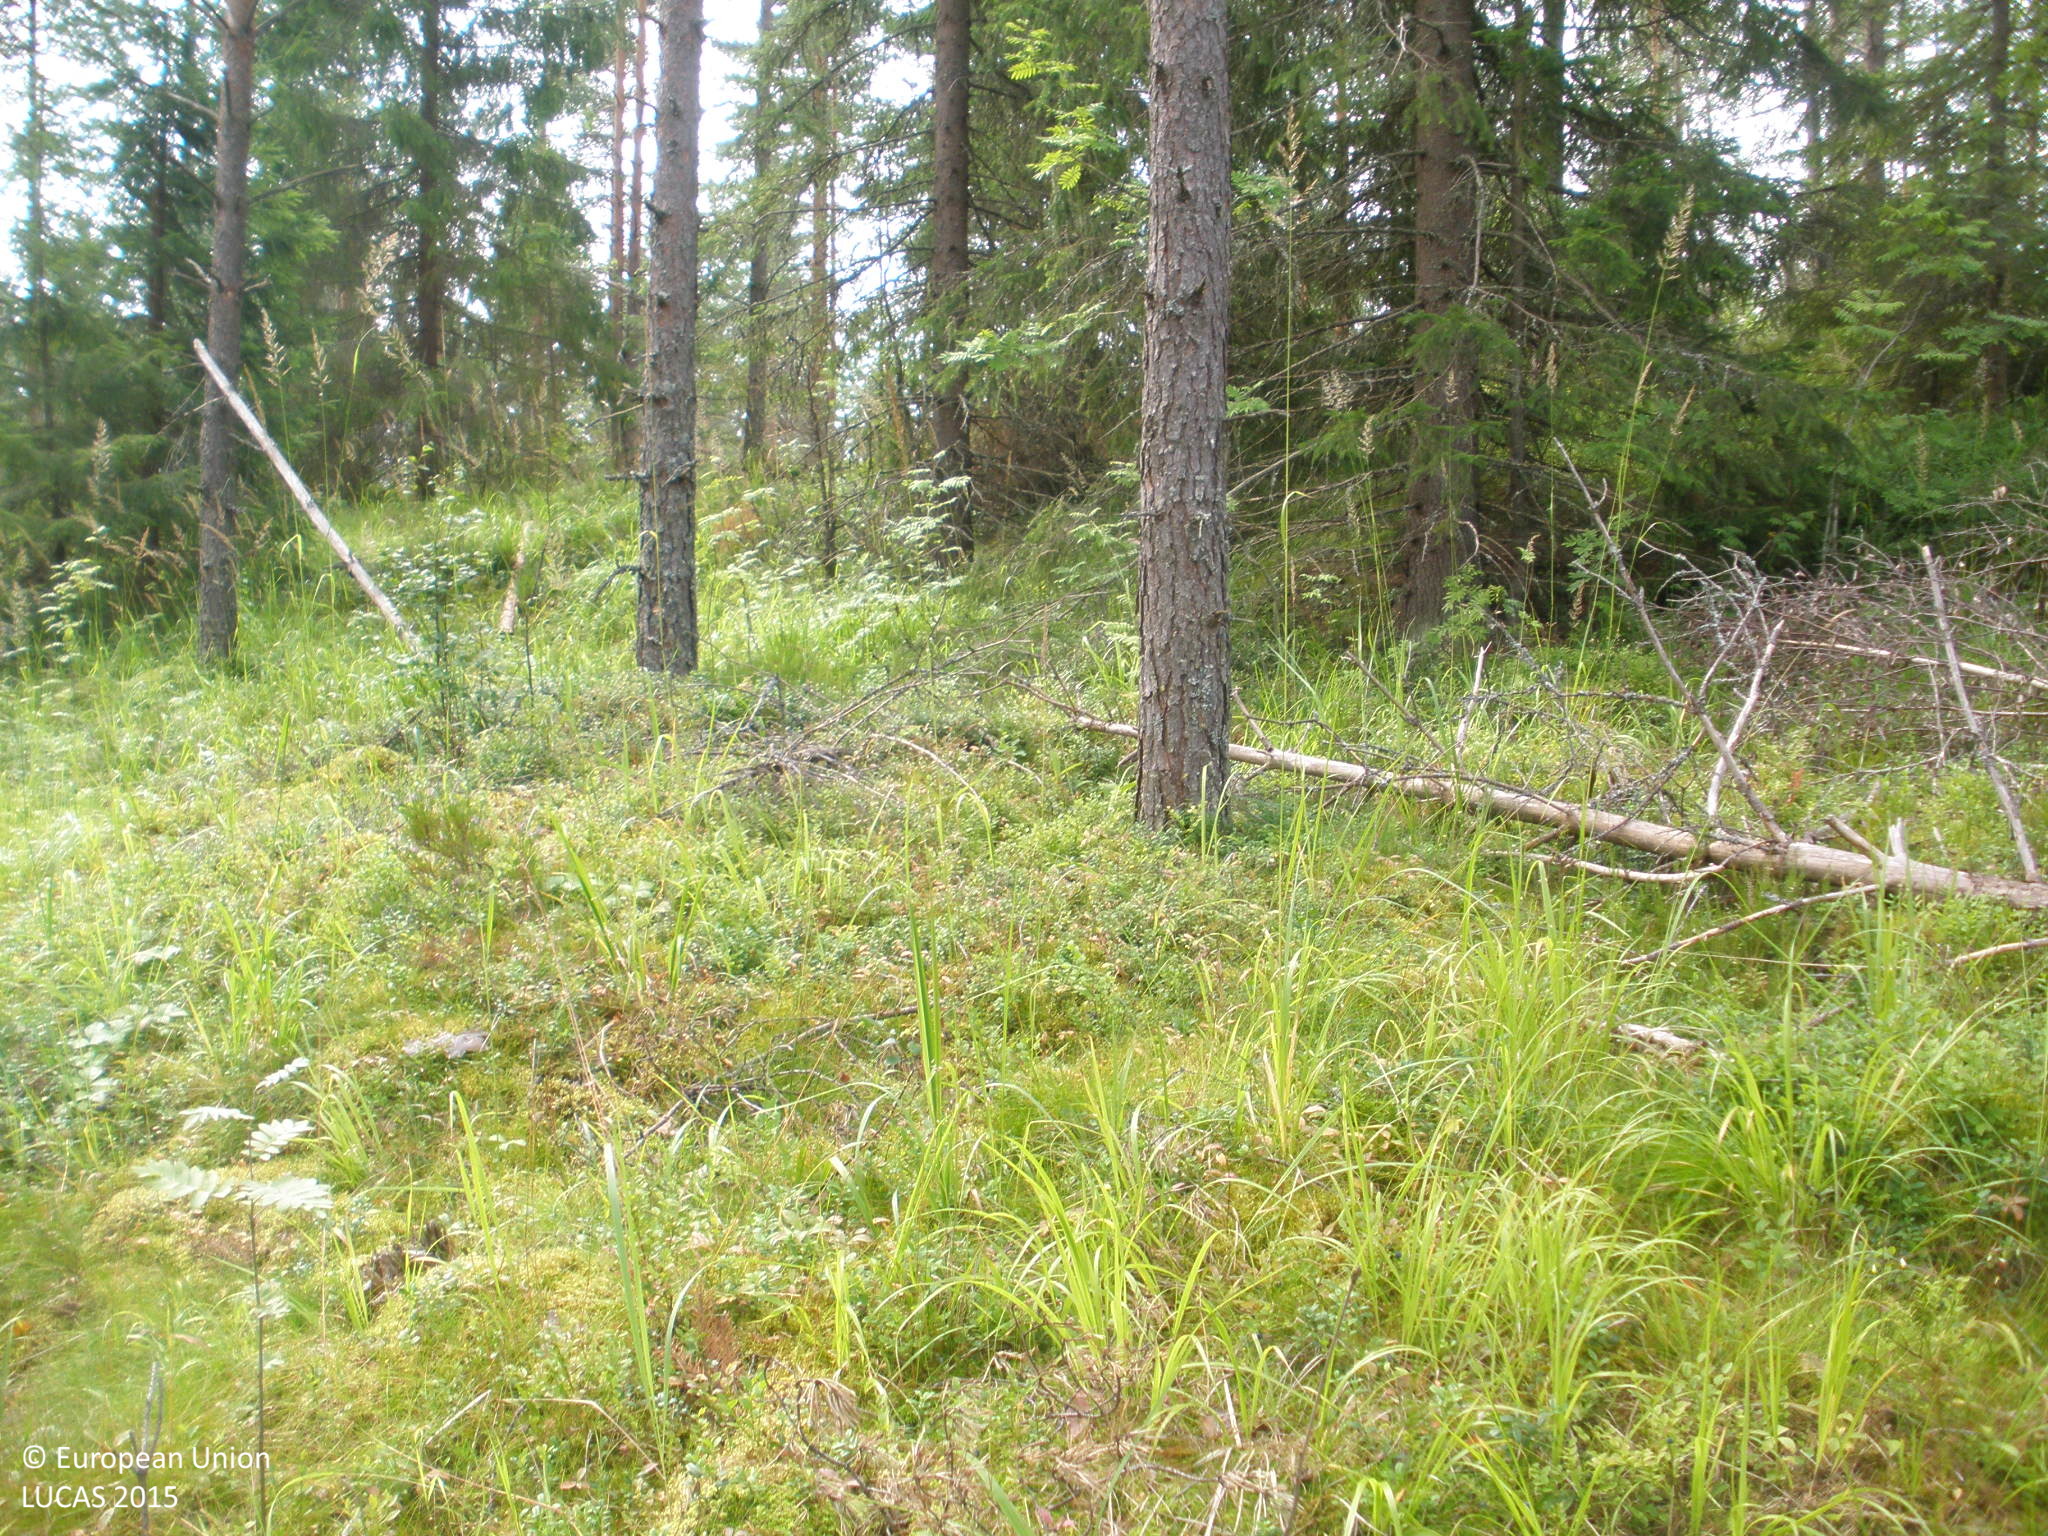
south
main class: Woodland
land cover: Pine dominated coniferous woodland
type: boreal forest
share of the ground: > 75 %
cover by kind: coniferous forest trees 75 %, herbaceous plants 10 %, lichens and mosses 10 %, shrubs 5 %
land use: Forestry
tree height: > 5 m
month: August
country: FI
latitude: 60.6107
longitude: 24.0343
